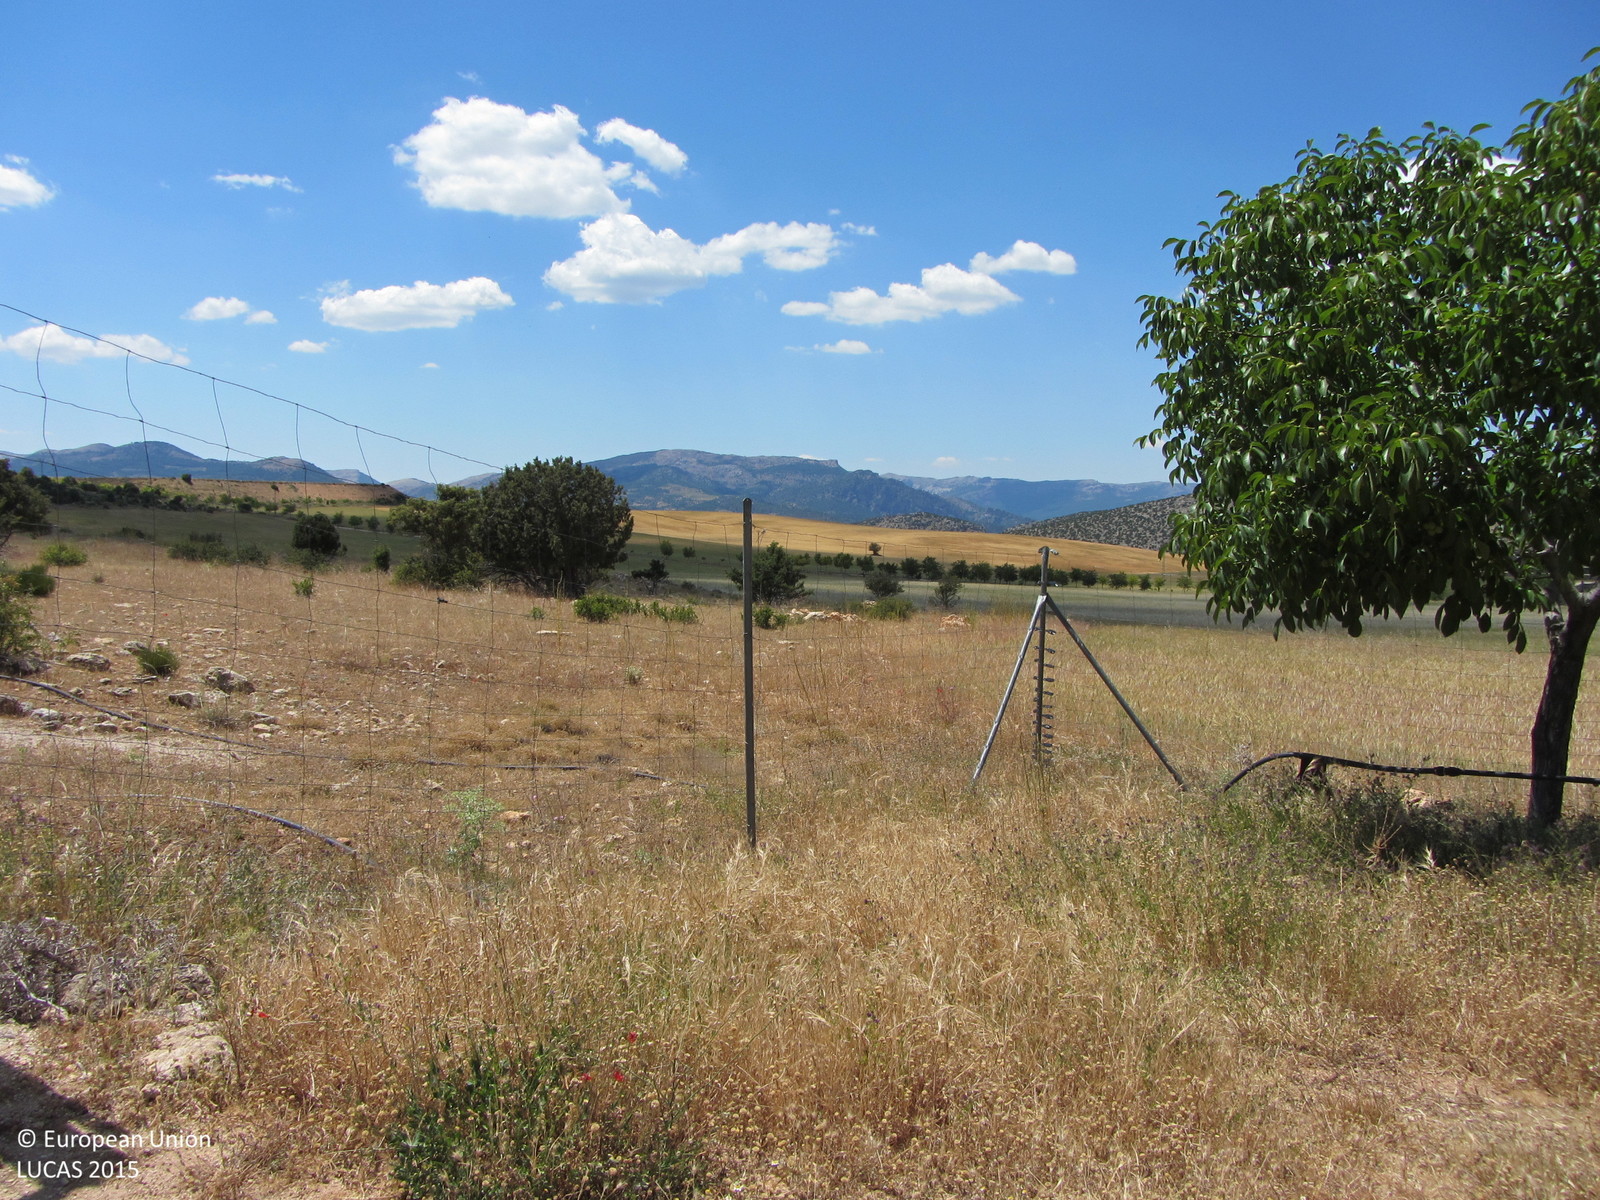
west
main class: Woodland
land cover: Broadleaved woodland
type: broadleaved evergreen forest
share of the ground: > 75 %
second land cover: Shrubland without tree cover
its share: 10 - 25 %
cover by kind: broadleaved forest trees 80 %, shrubs 10 %, consolidated bare surface 10 %
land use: Forestry
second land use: Agriculture (excluding fallow land and kitchen gardens)
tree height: > 5 m
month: June
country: ES
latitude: 38.1779
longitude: -2.4028
